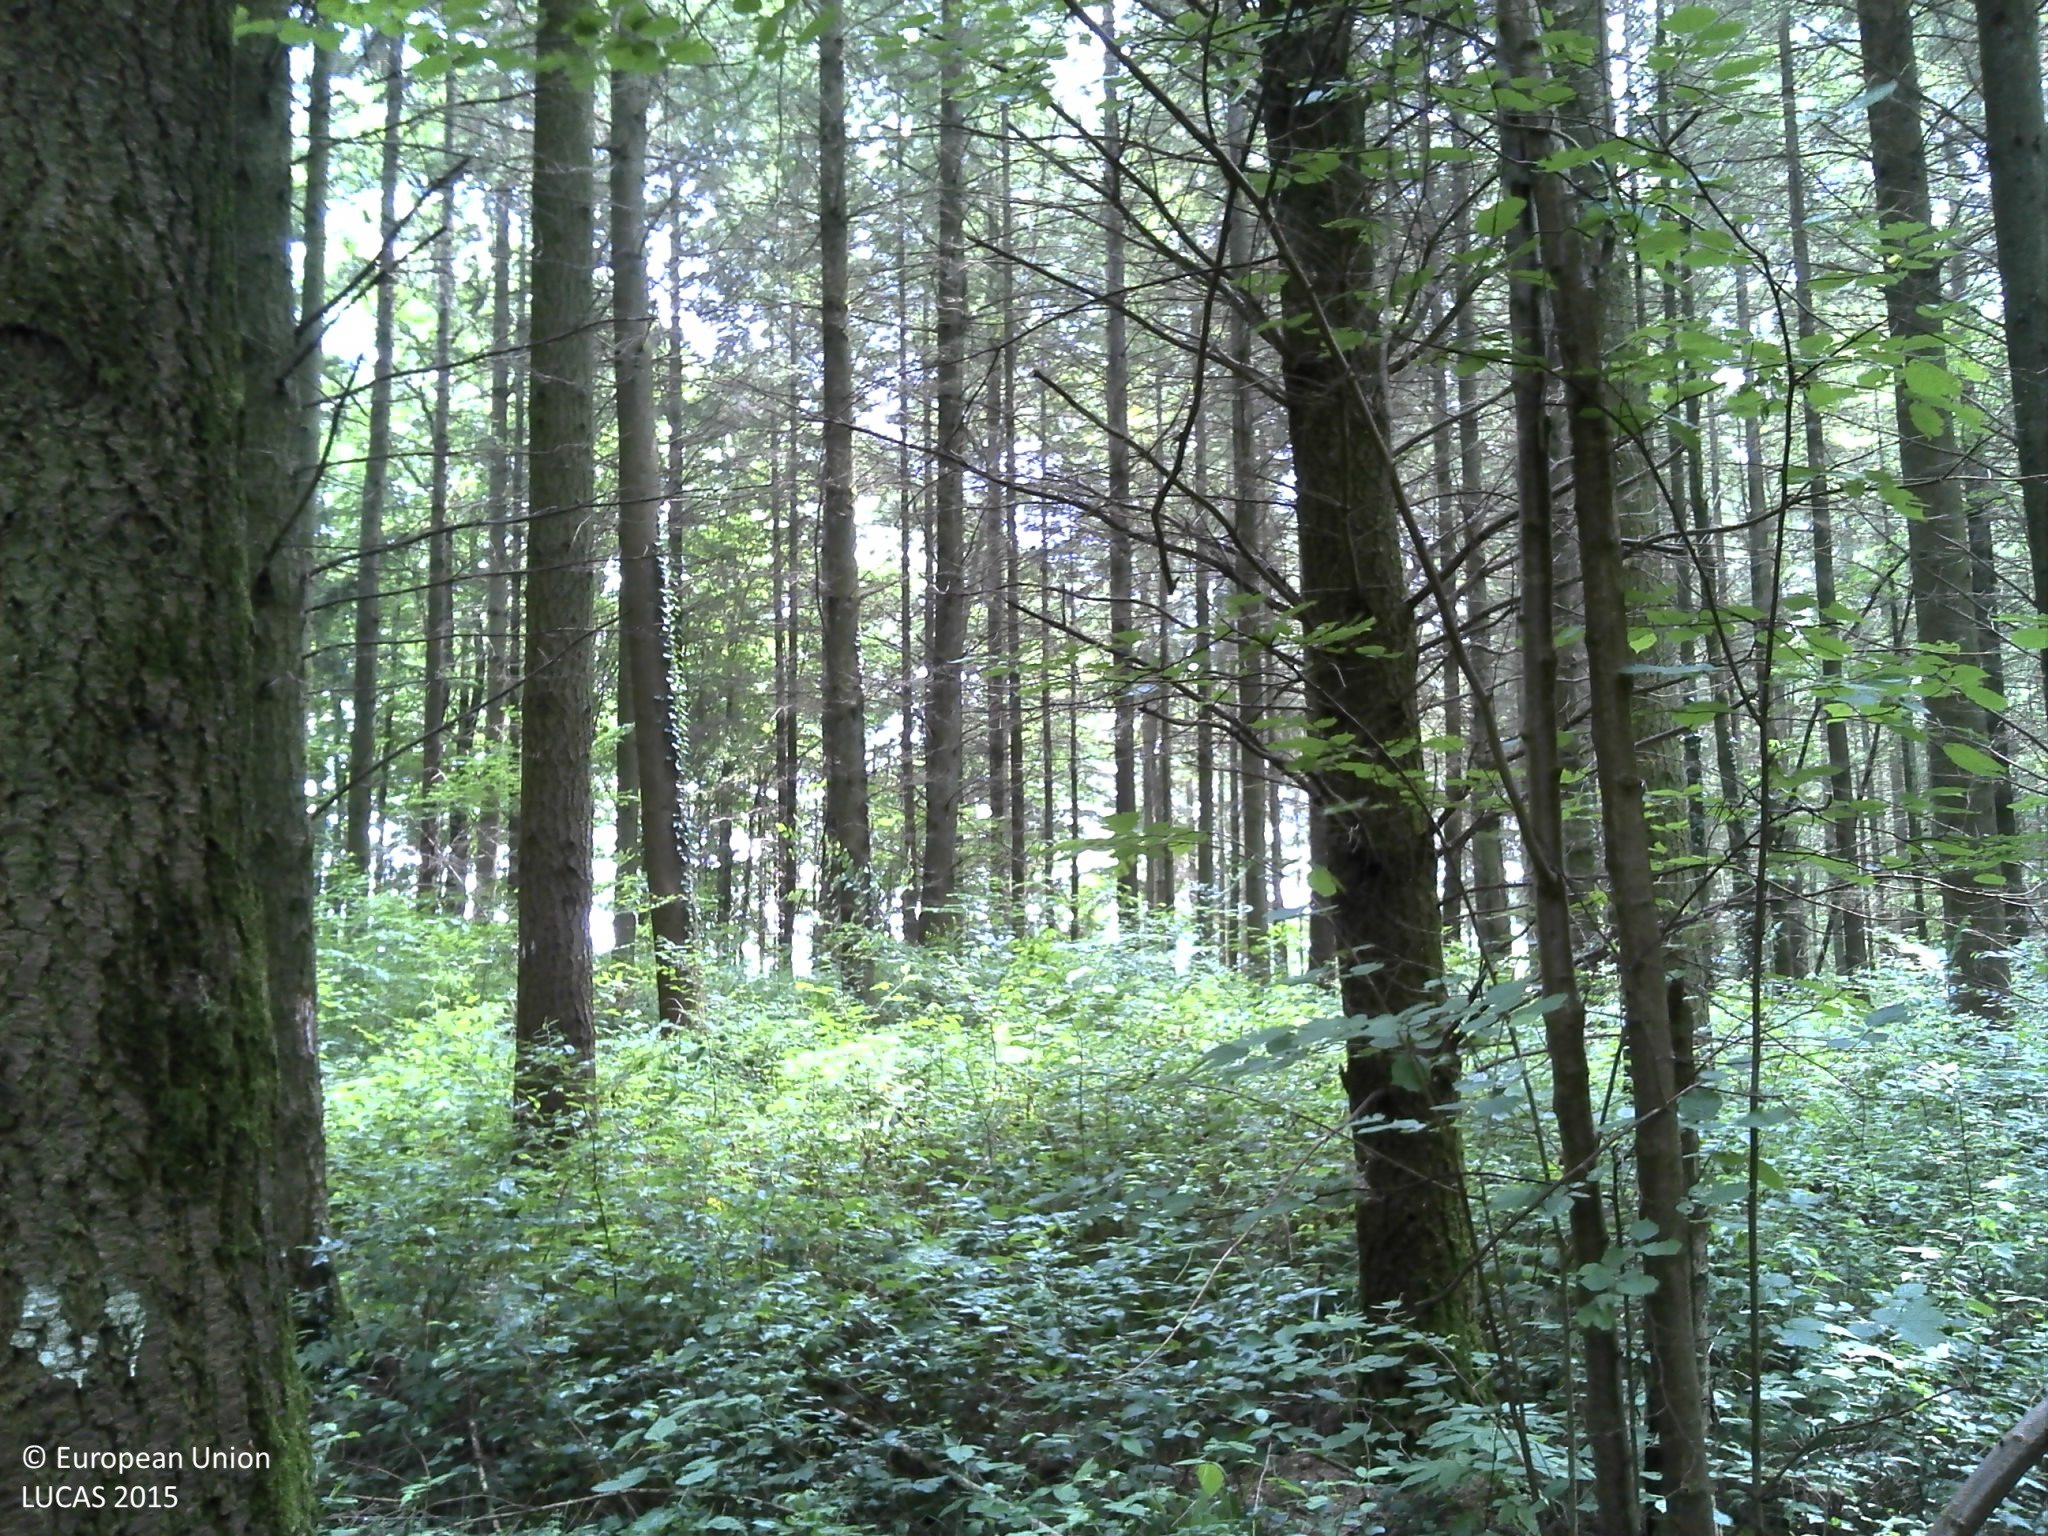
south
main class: Woodland
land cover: Spruce dominated coniferous woodland
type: exotic forest
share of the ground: 50 - 75 %
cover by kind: coniferous forest trees 60 %, herbaceous plants 20 %, broadleaved forest trees 10 %, lichens and mosses 10 %
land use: Forestry
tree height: > 5 m
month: June
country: FR
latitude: 49.3643
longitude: 4.8335
